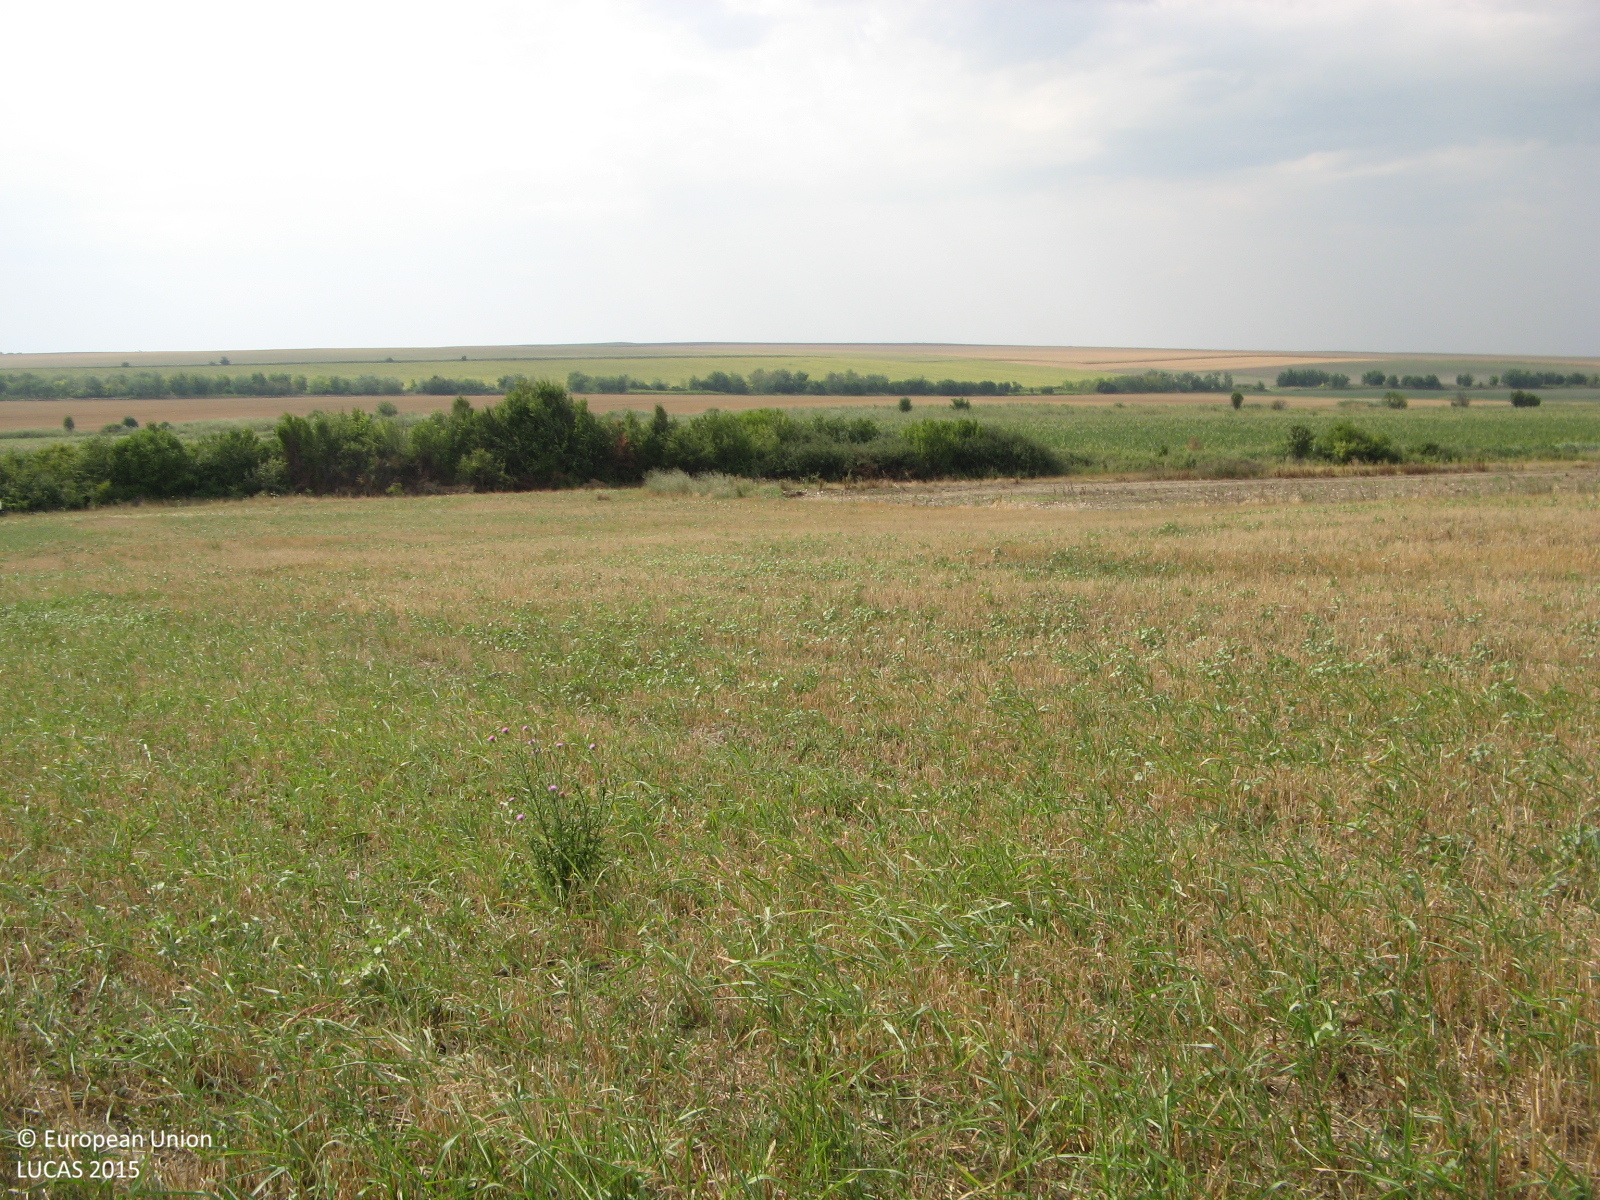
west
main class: Cropland
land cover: Common wheat
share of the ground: 50 - 75 %
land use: Agriculture (excluding fallow land and kitchen gardens)
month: August
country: BG
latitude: 43.4694
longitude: 25.2683
